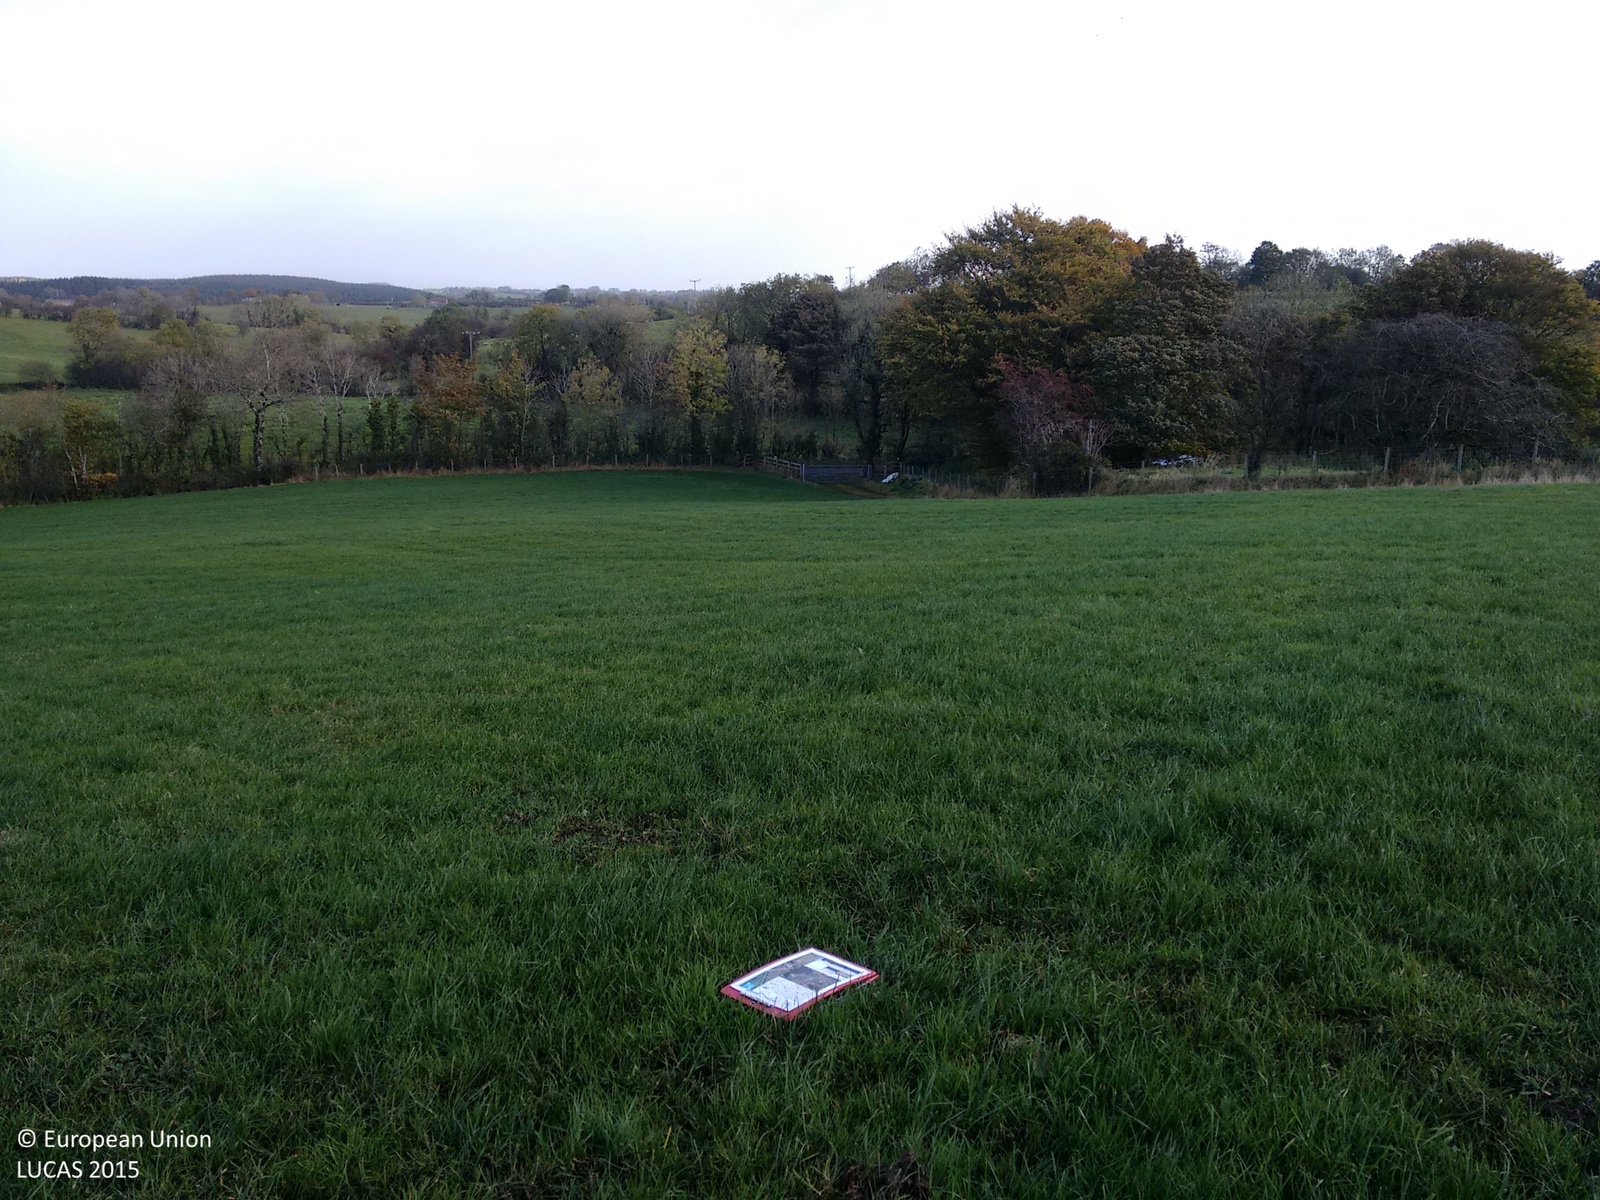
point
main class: Grassland
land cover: Grassland without tree/shrub cover
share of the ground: > 75 %
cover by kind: herbaceous plants 100 %
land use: Agriculture (excluding fallow land and kitchen gardens)
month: October
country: GB
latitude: 54.4830
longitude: -7.4251
